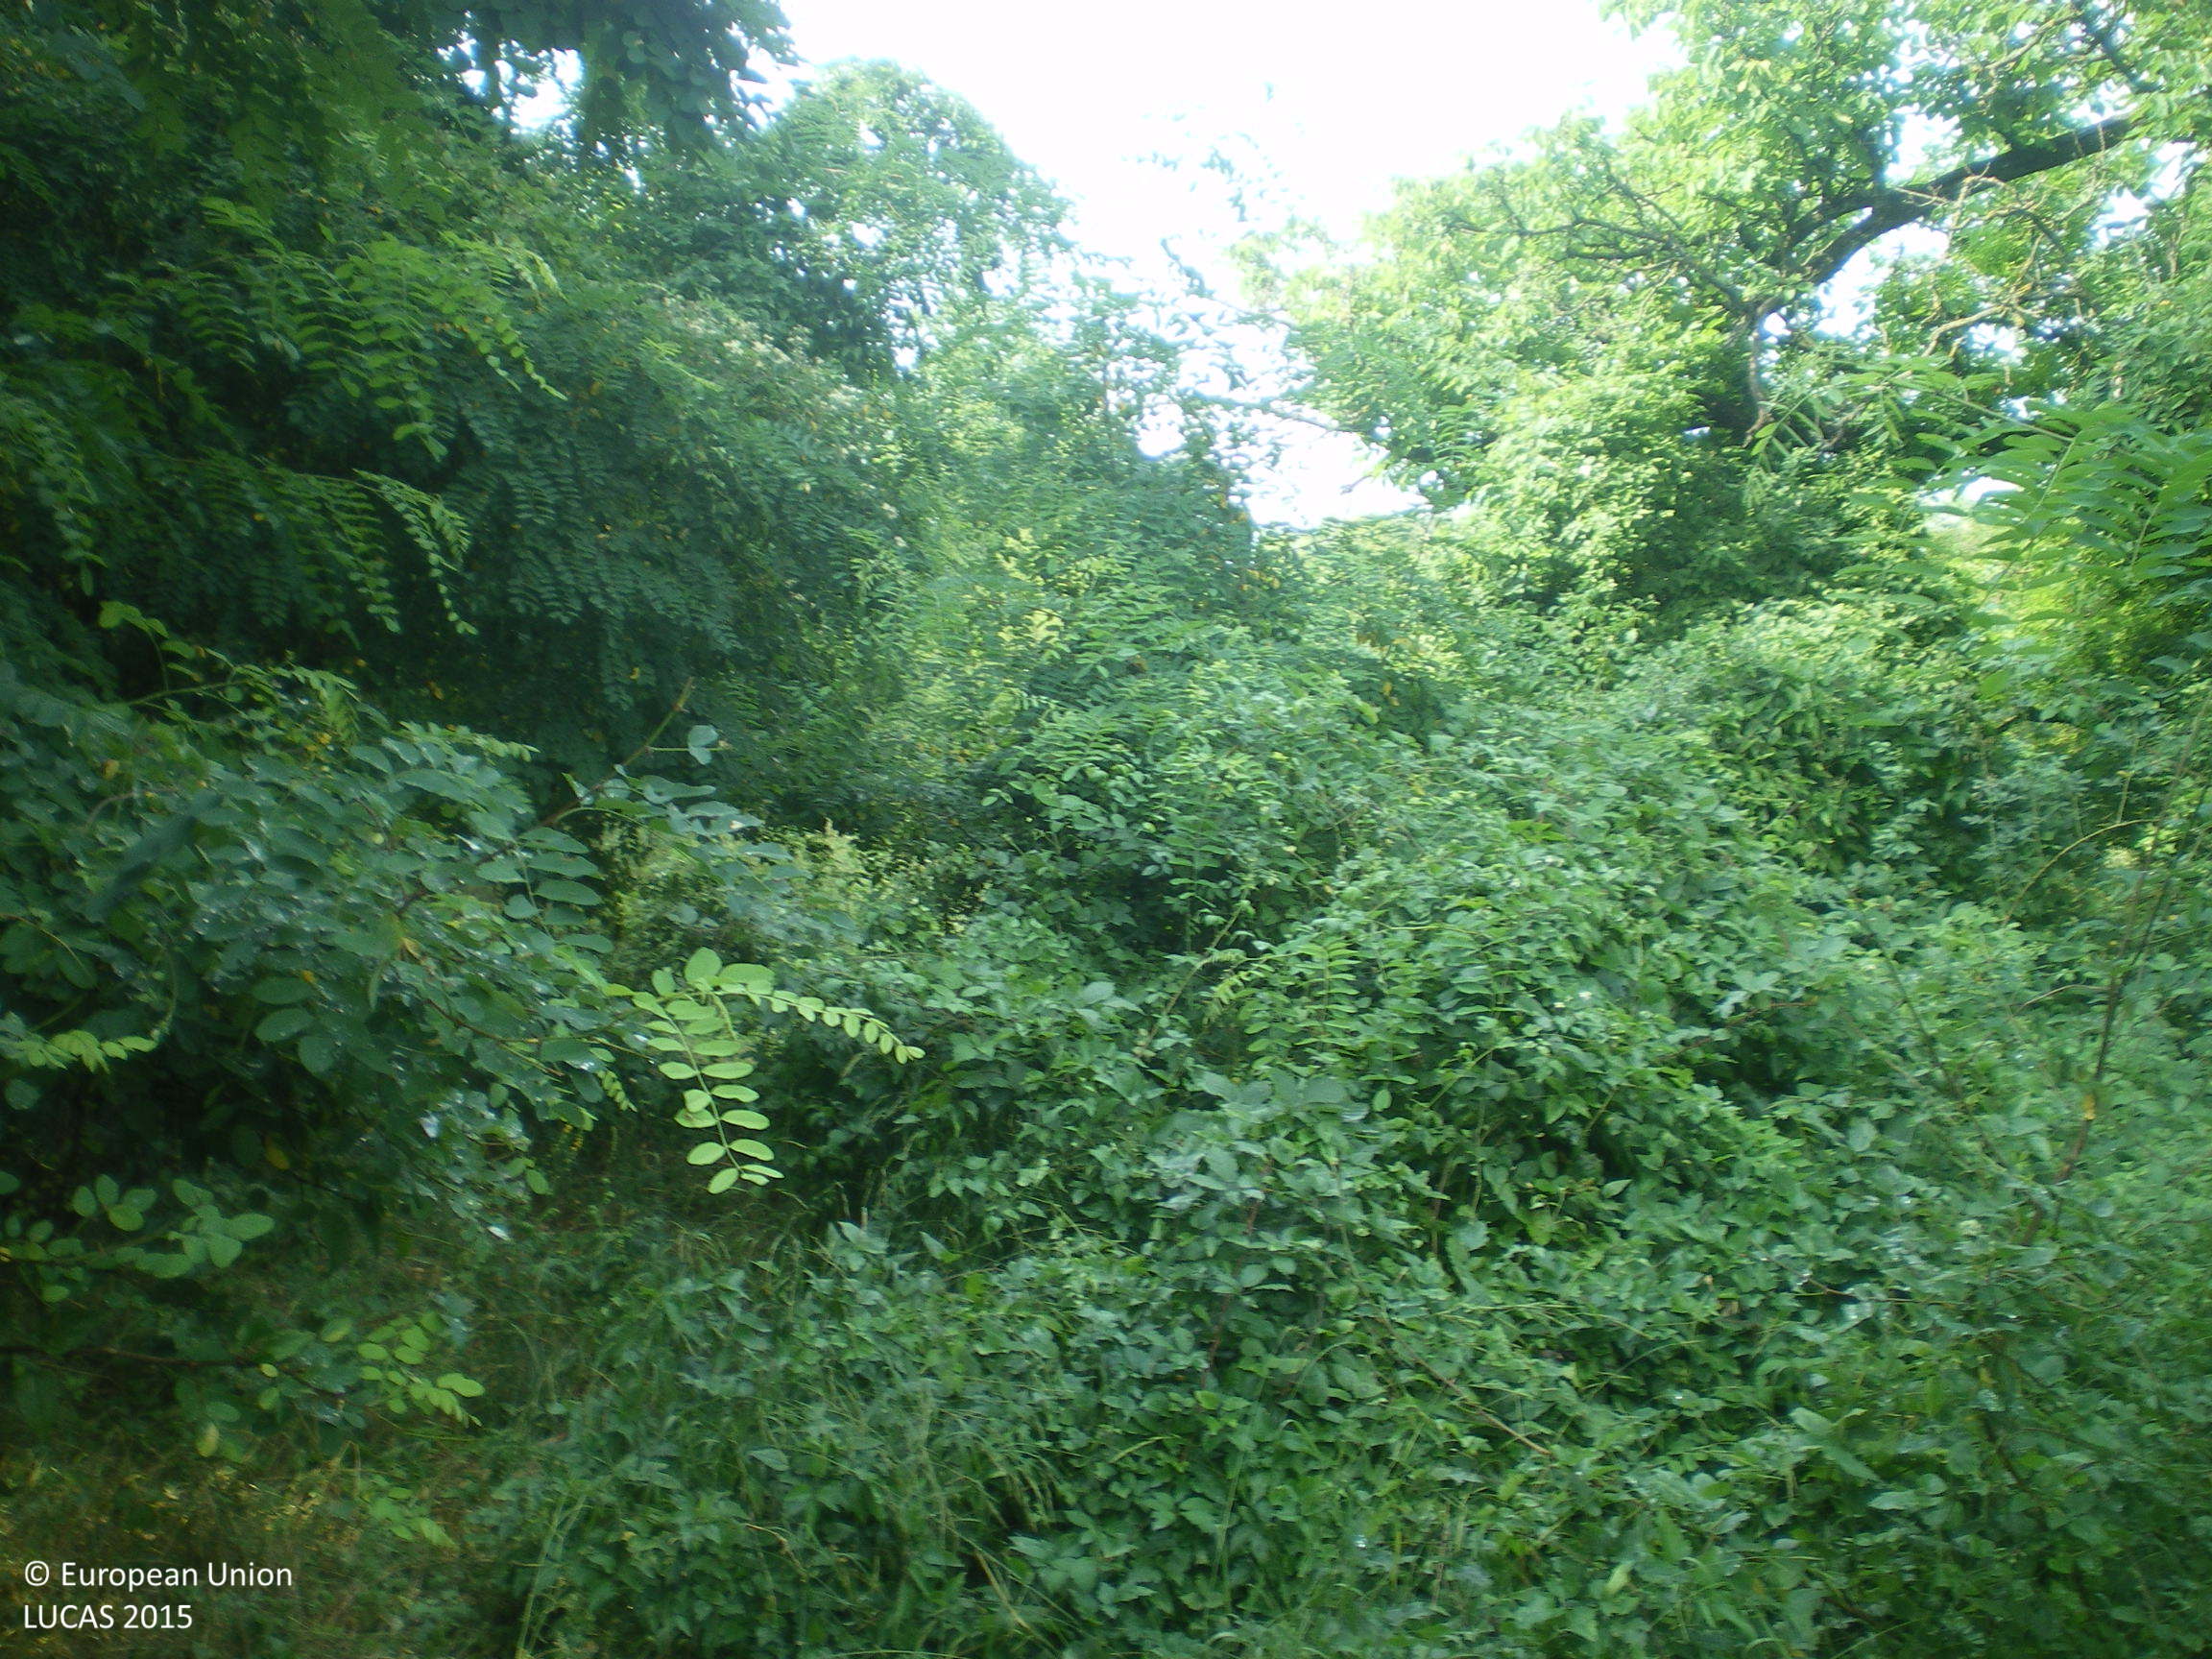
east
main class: Woodland
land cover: Broadleaved woodland
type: mesophytic deciduous forest
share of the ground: 50 - 75 %
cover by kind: broadleaved forest trees 50 %, herbaceous plants 30 %, shrubs 20 %
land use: Semi-natural and natural areas not in use
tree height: > 5 m
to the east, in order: Broadleaved woodland; Shrubland with sparse tree cover; Tracks; Broadleaved woodland; Inland fresh running water; Fences; Broadleaved woodland; Other fruit trees and berries; Fences; Tracks; Shrubland with sparse tree cover; Tracks; Broadleaved woodland
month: July
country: BG
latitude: 42.3888
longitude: 25.2599
